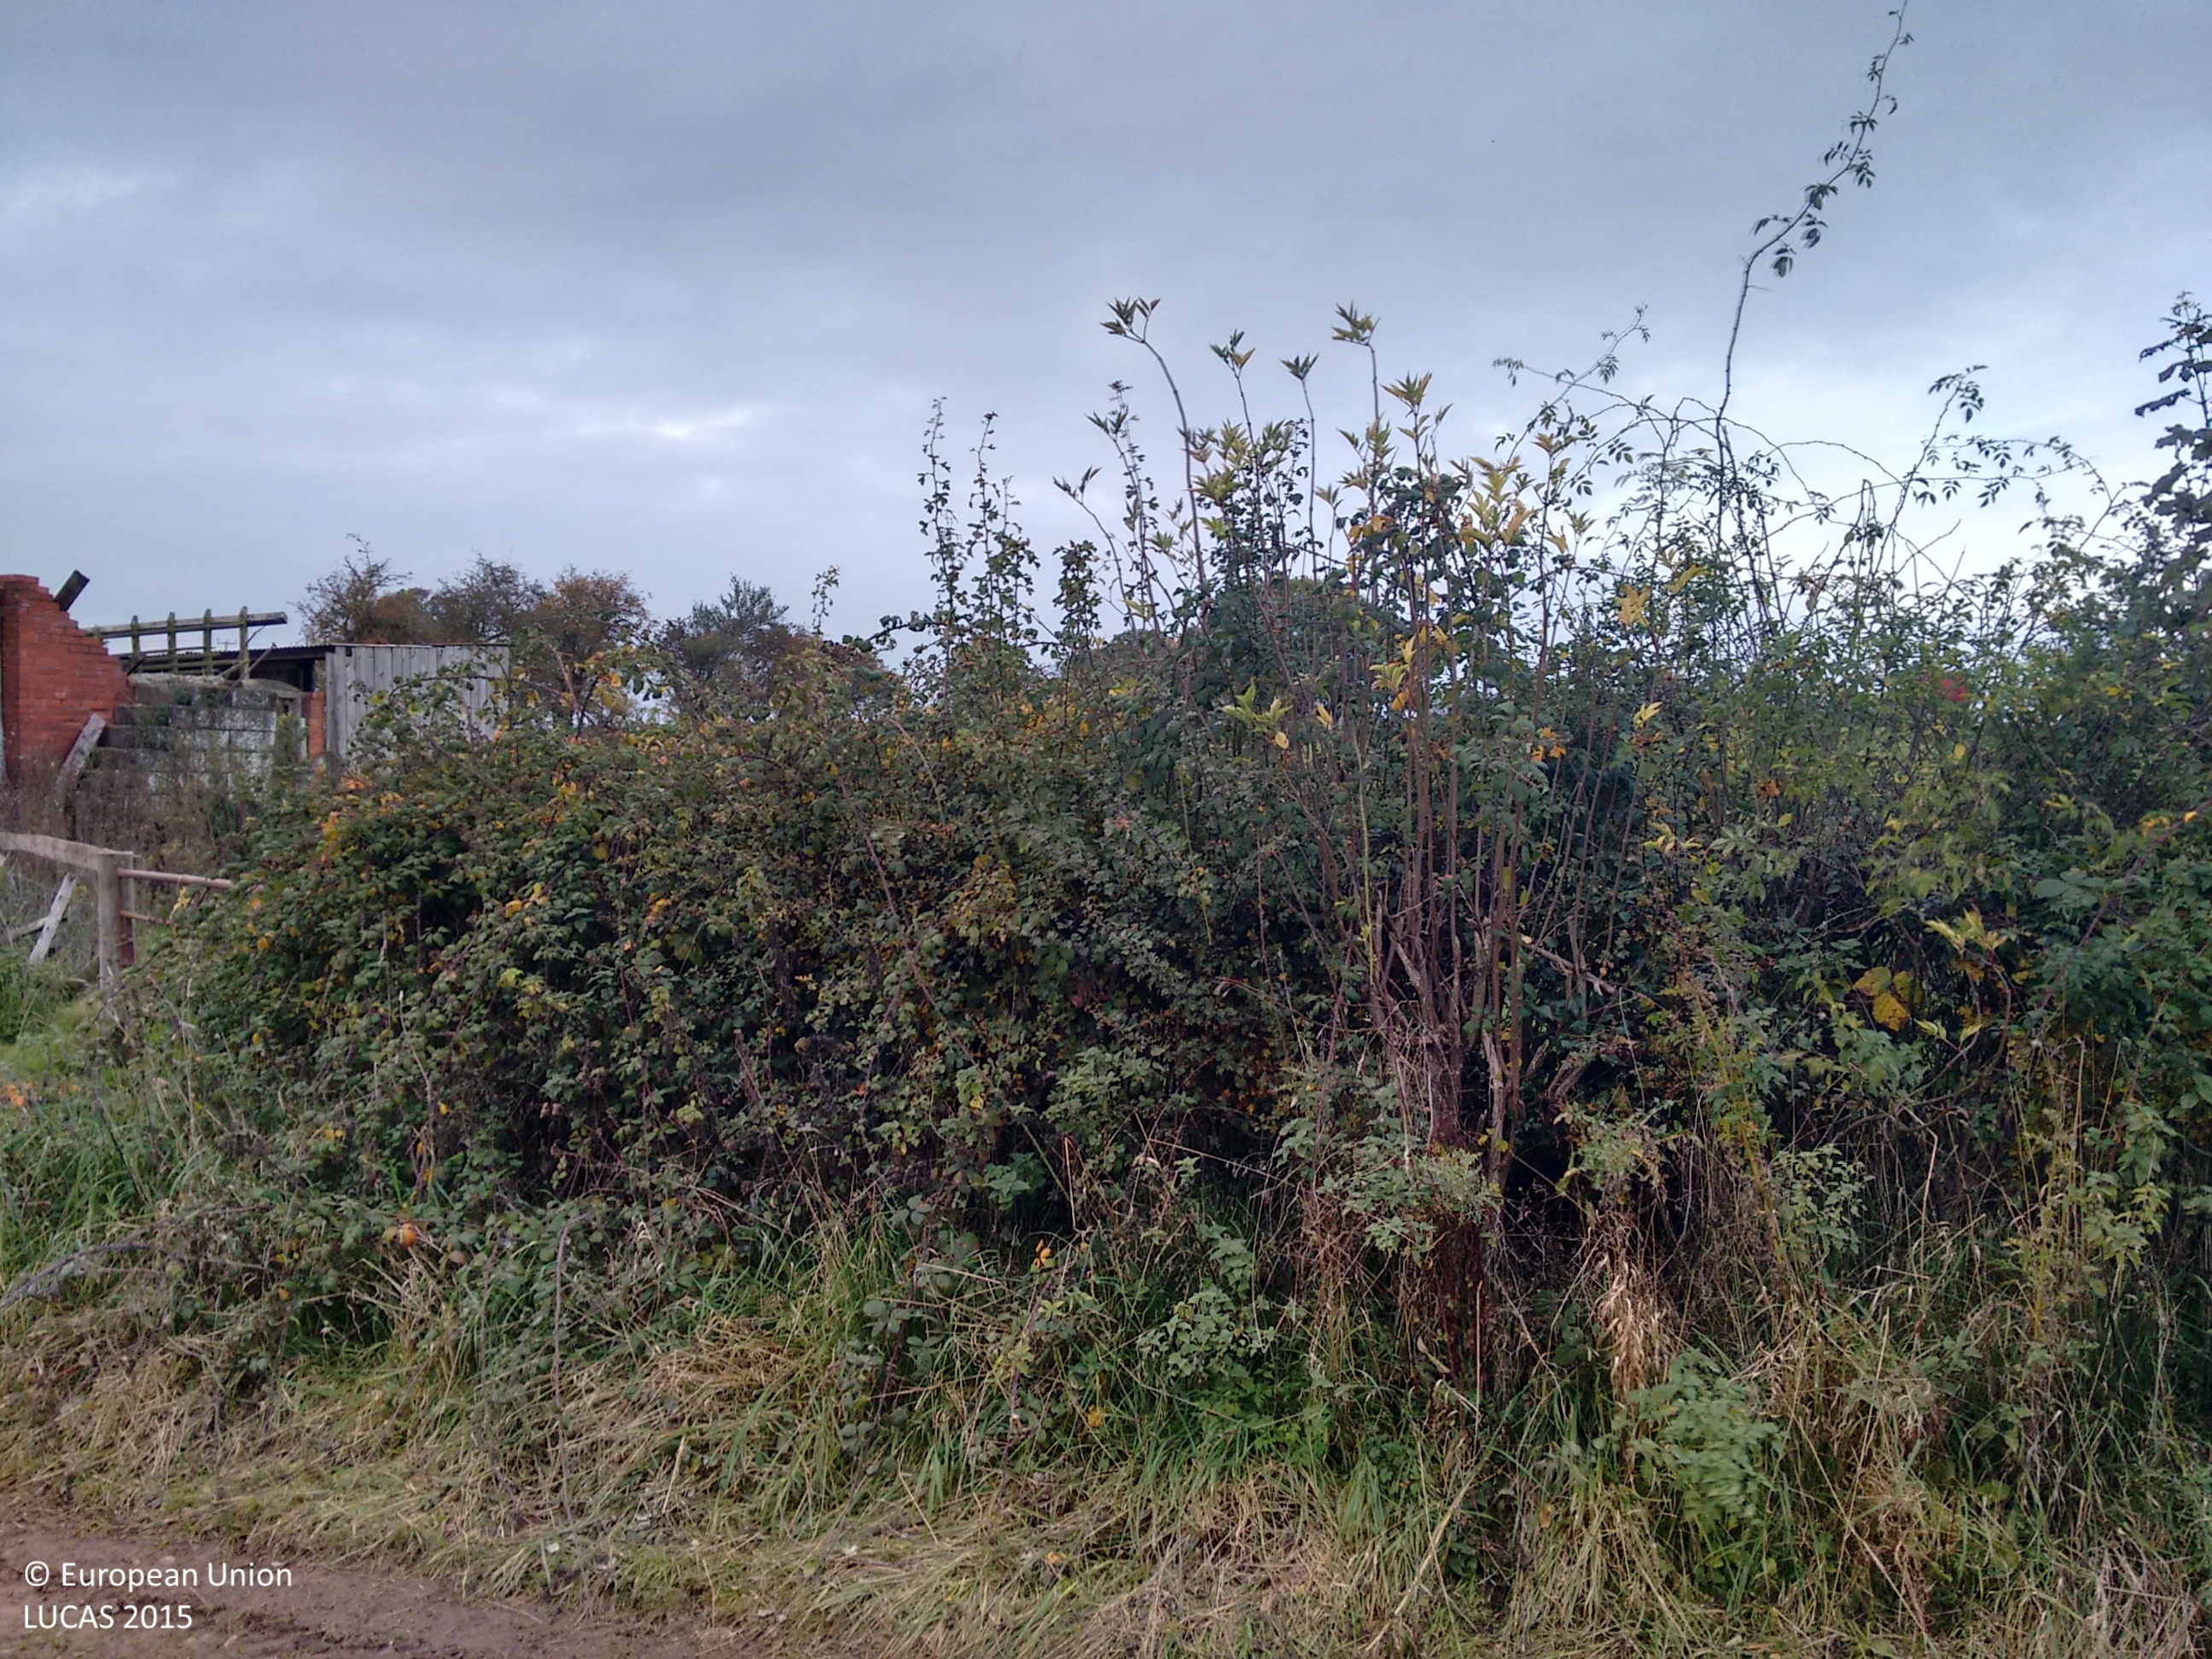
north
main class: Grassland
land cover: Grassland without tree/shrub cover
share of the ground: > 75 %
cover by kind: herbaceous plants 100 %
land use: Agriculture (excluding fallow land and kitchen gardens)
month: October
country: GB
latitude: 52.3962
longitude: -2.7534
